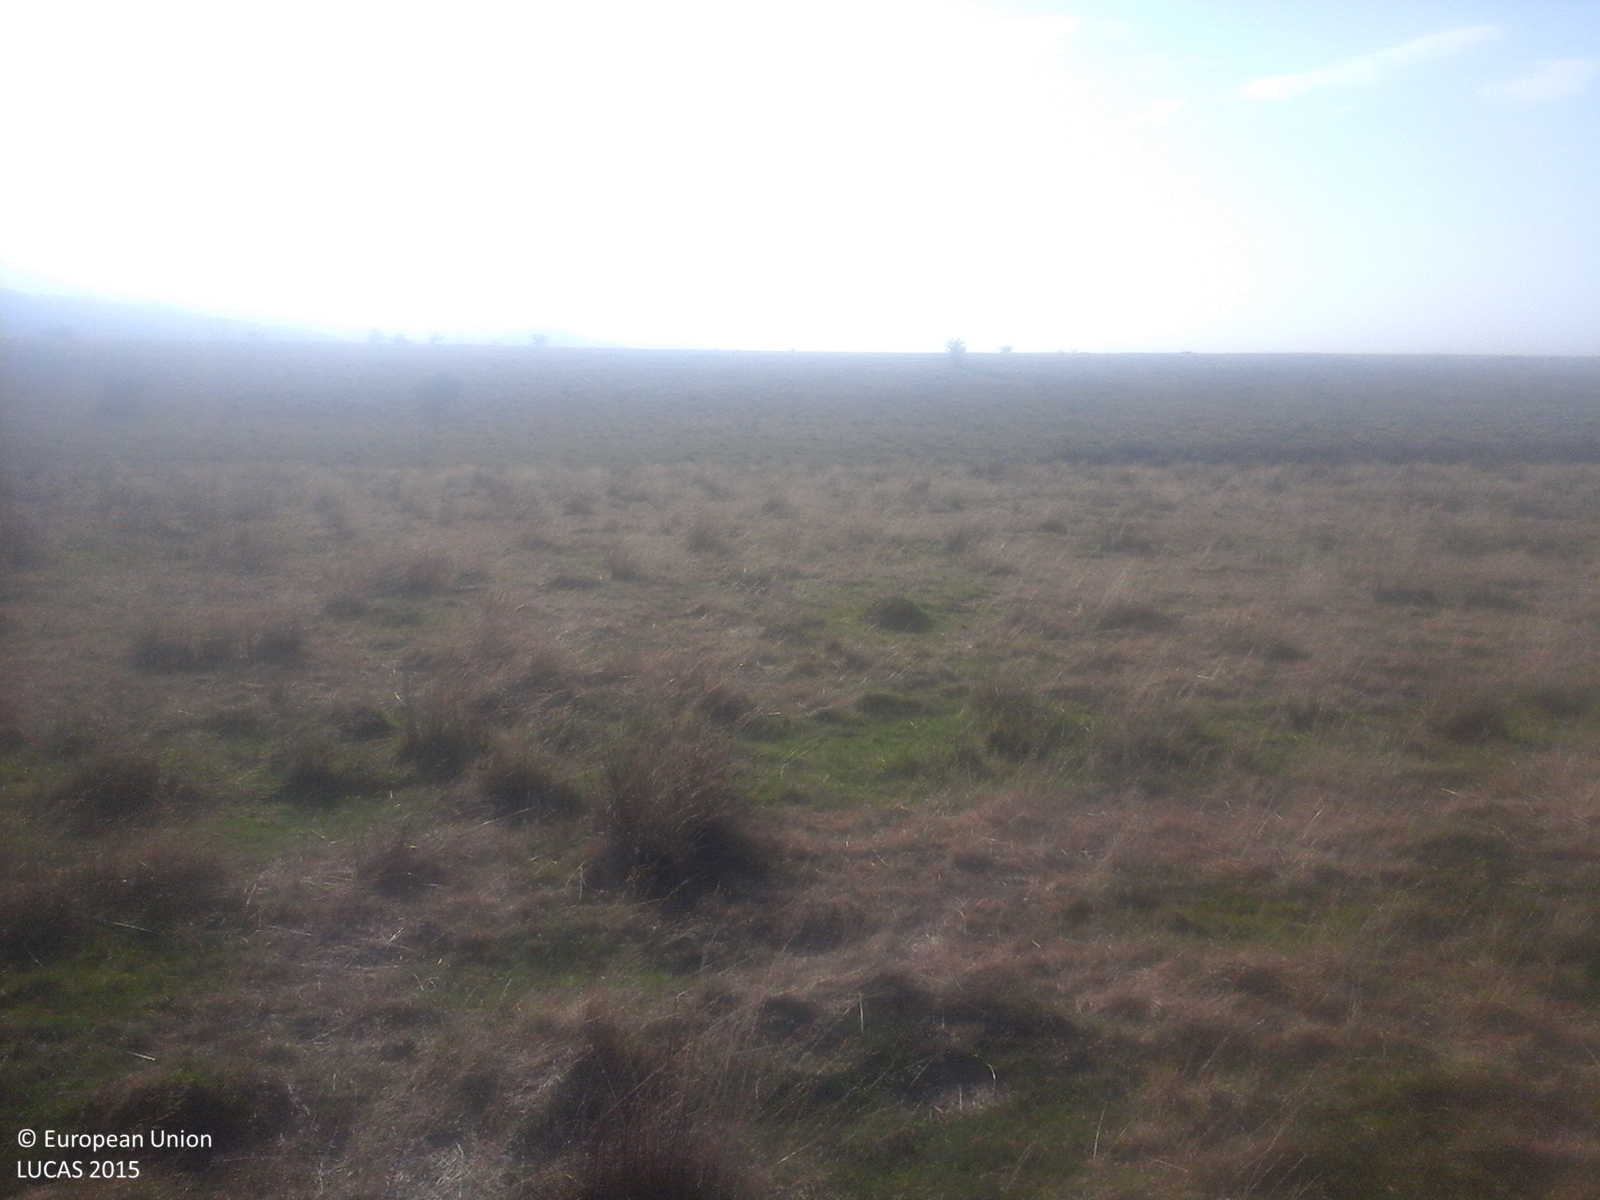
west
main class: Grassland
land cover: Grassland without tree/shrub cover
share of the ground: > 75 %
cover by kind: herbaceous plants 100 %
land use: Agriculture (excluding fallow land and kitchen gardens)
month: September
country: RO
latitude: 45.4909
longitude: 23.0669
